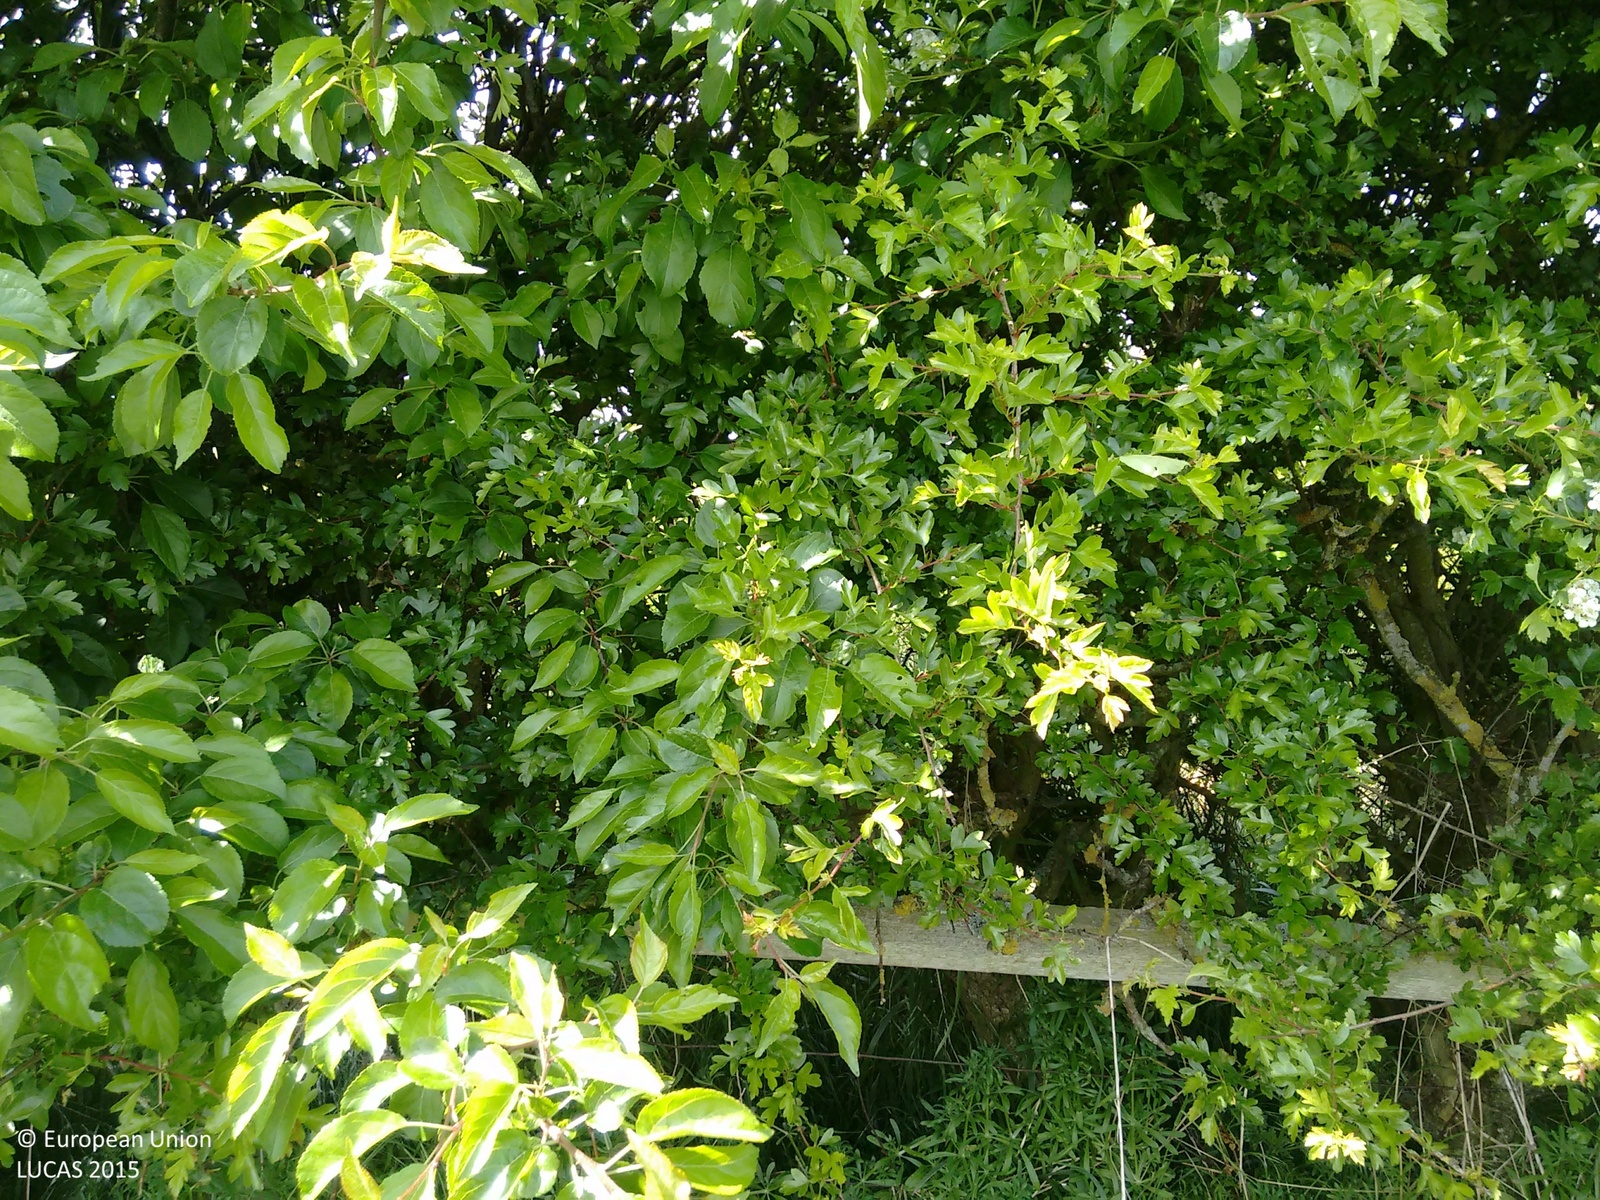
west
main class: Cropland
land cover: Barley
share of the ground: > 75 %
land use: Agriculture (excluding fallow land and kitchen gardens)
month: June
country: GB
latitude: 55.6324
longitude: -2.2717
